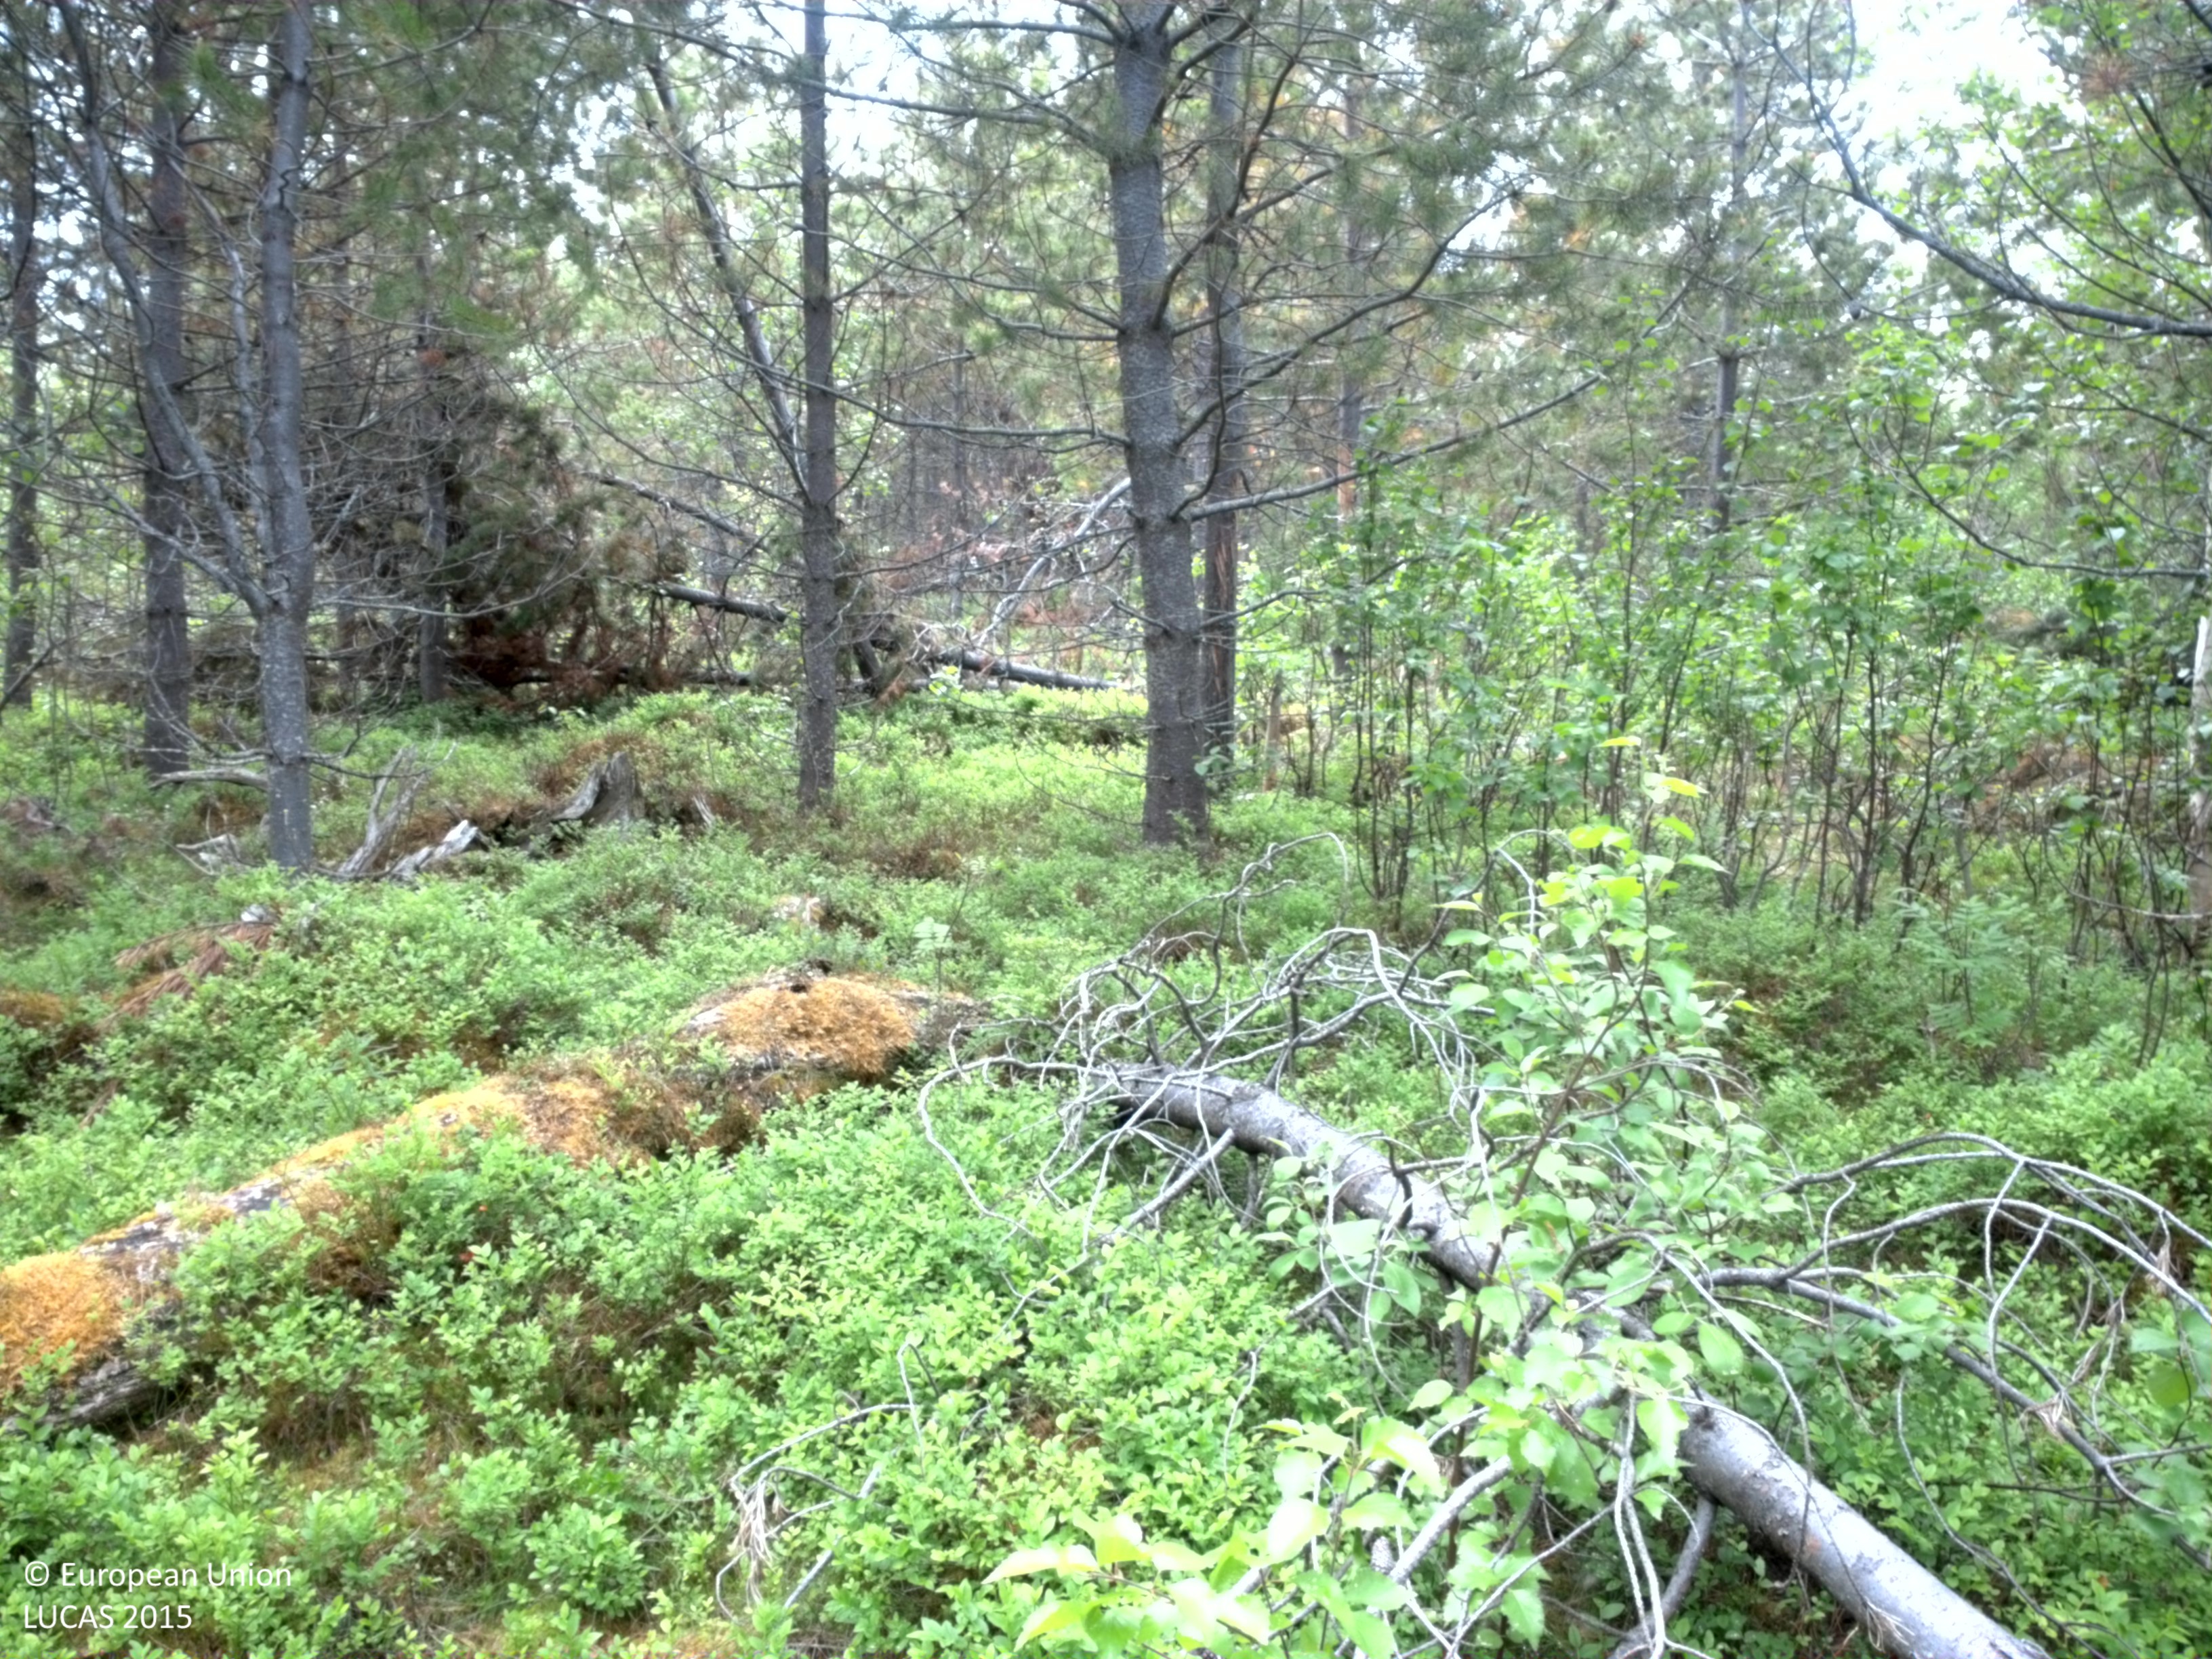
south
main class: Woodland
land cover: Pine dominated coniferous woodland
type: exotic forest
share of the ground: 50 - 75 %
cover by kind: coniferous forest trees 65 %, broadleaved forest trees 15 %, shrubs 15 %, herbaceous plants 5 %
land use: Forestry
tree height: > 5 m
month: July
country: SE
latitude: 64.4700
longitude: 17.9741
